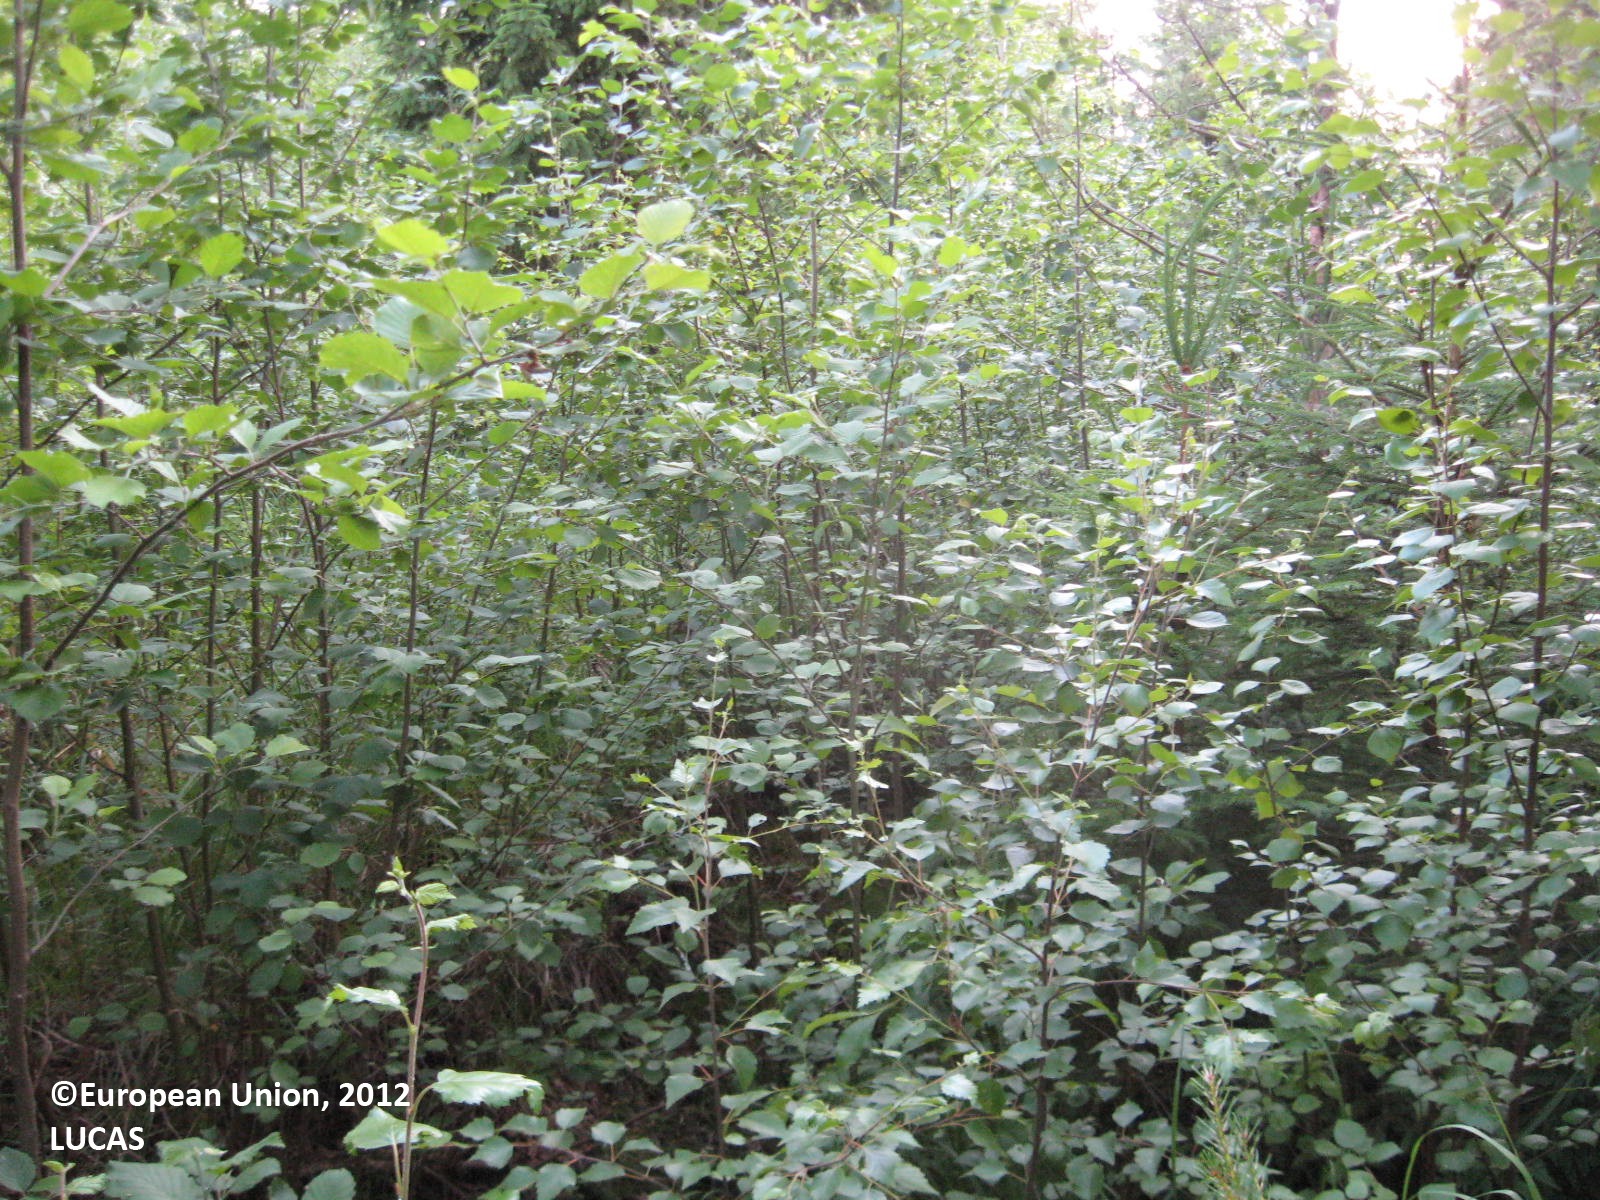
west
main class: Woodland
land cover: Broadleaved woodland
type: boreal forest
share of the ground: > 75 %
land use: Forestry
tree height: > 5 m
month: July
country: FI
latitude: 62.4888
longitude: 21.6298
